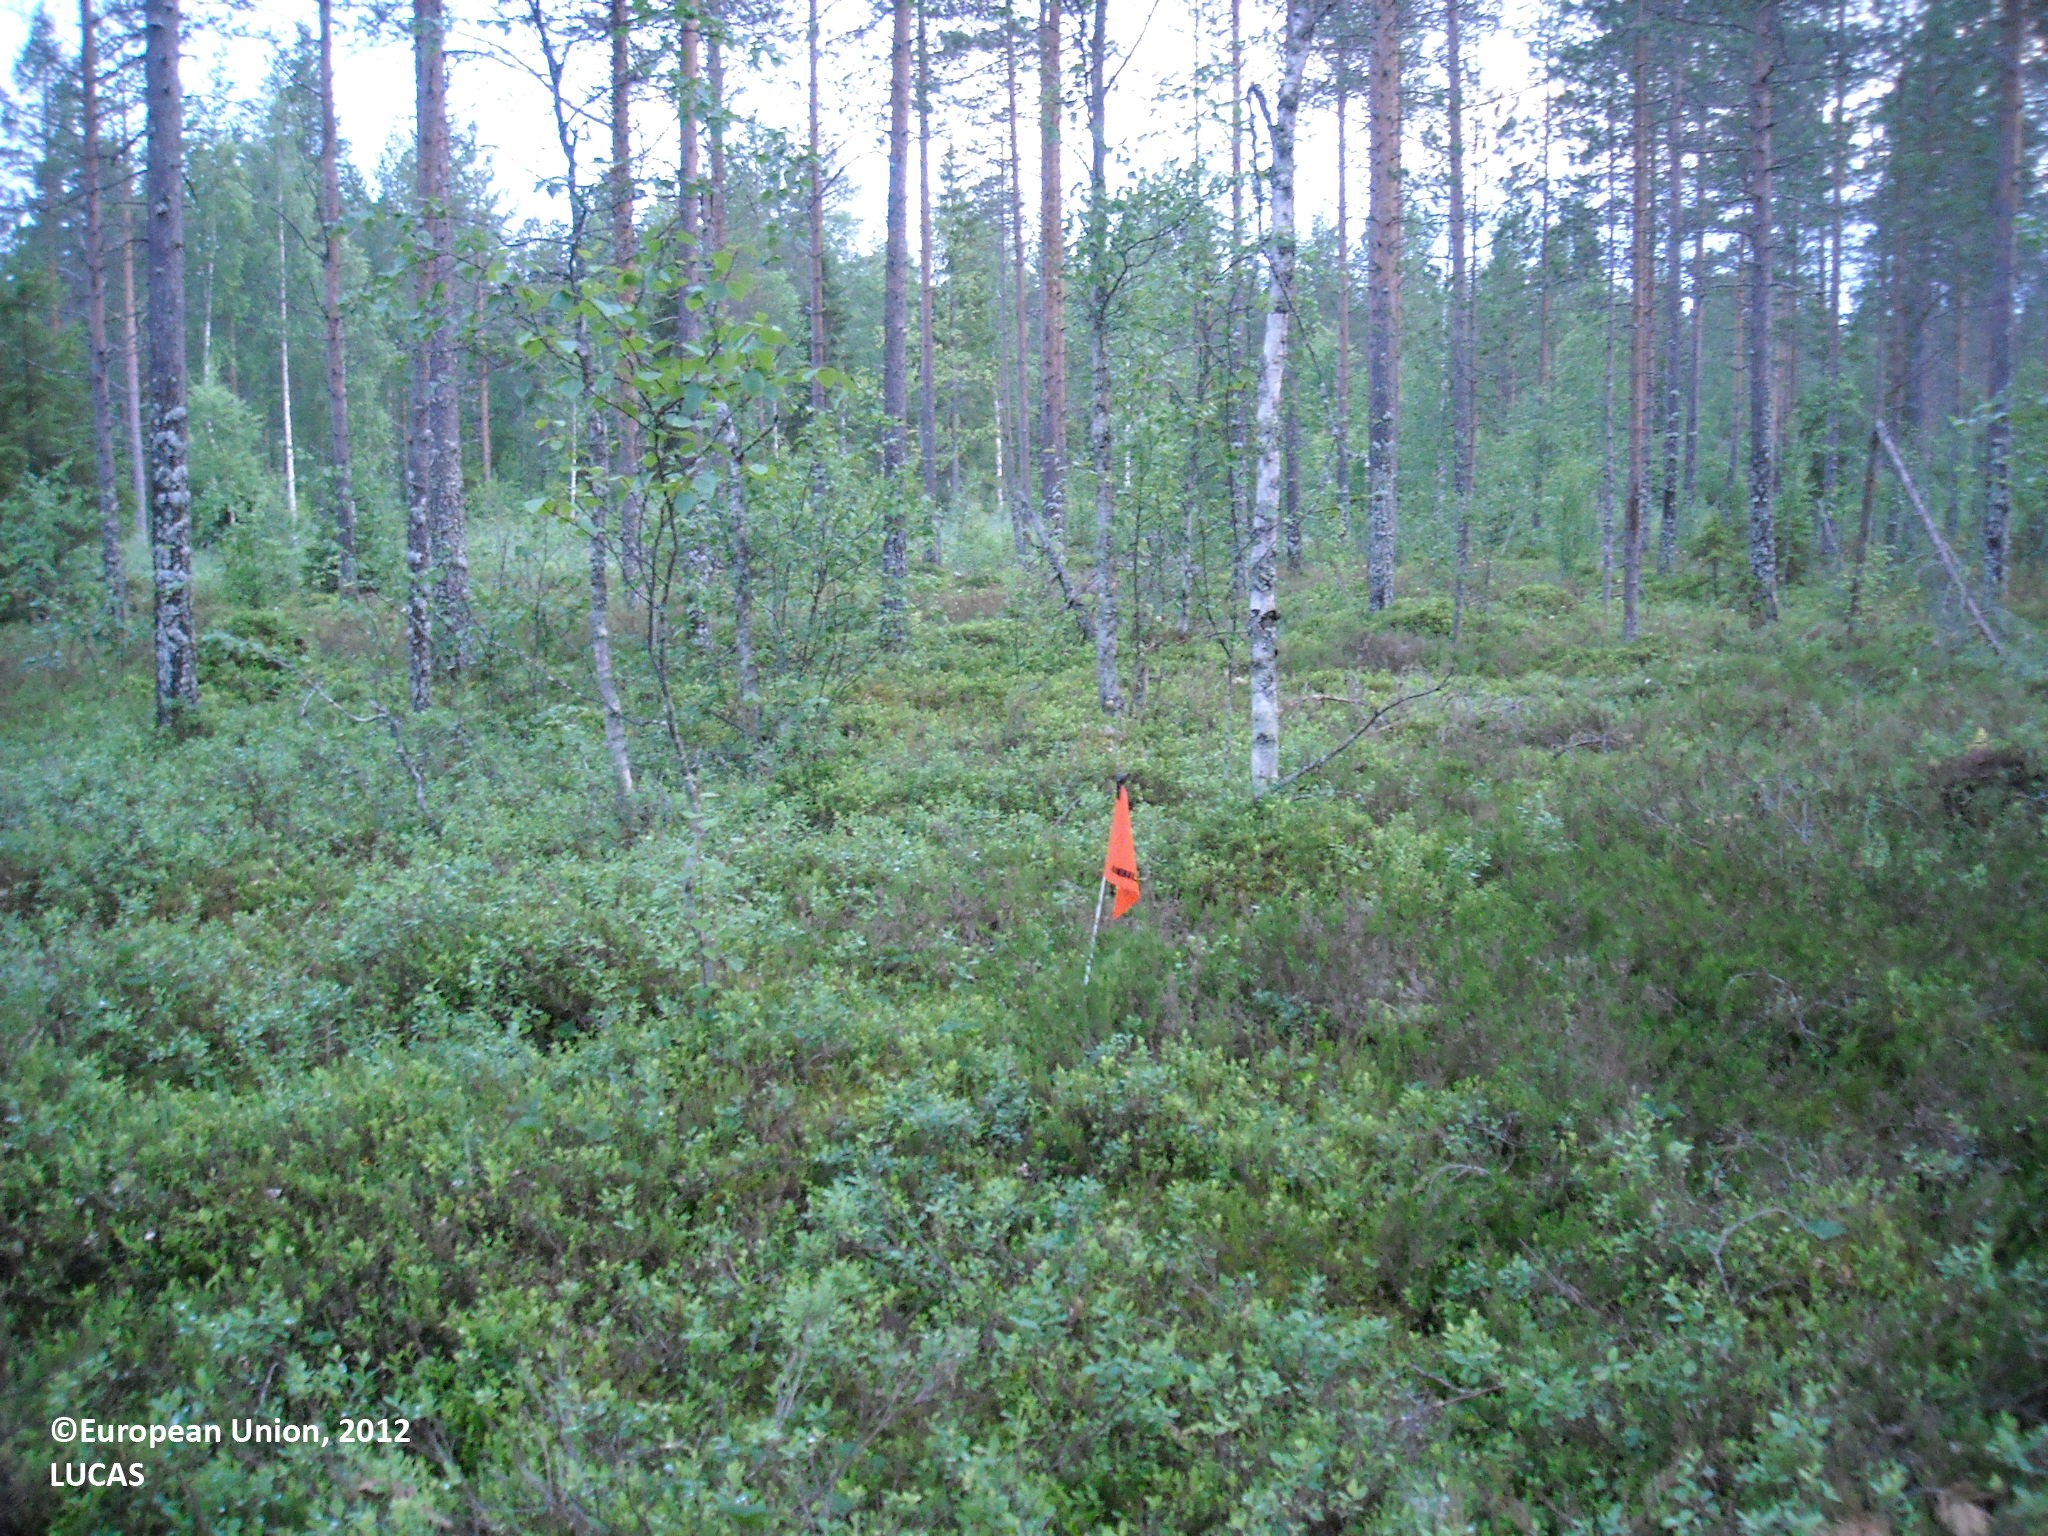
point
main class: Woodland
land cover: Pine dominated coniferous woodland
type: mire and swamp forests
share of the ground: 50 - 75 %
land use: Forestry
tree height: > 5 m
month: July
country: FI
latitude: 64.4549
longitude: 27.6702
